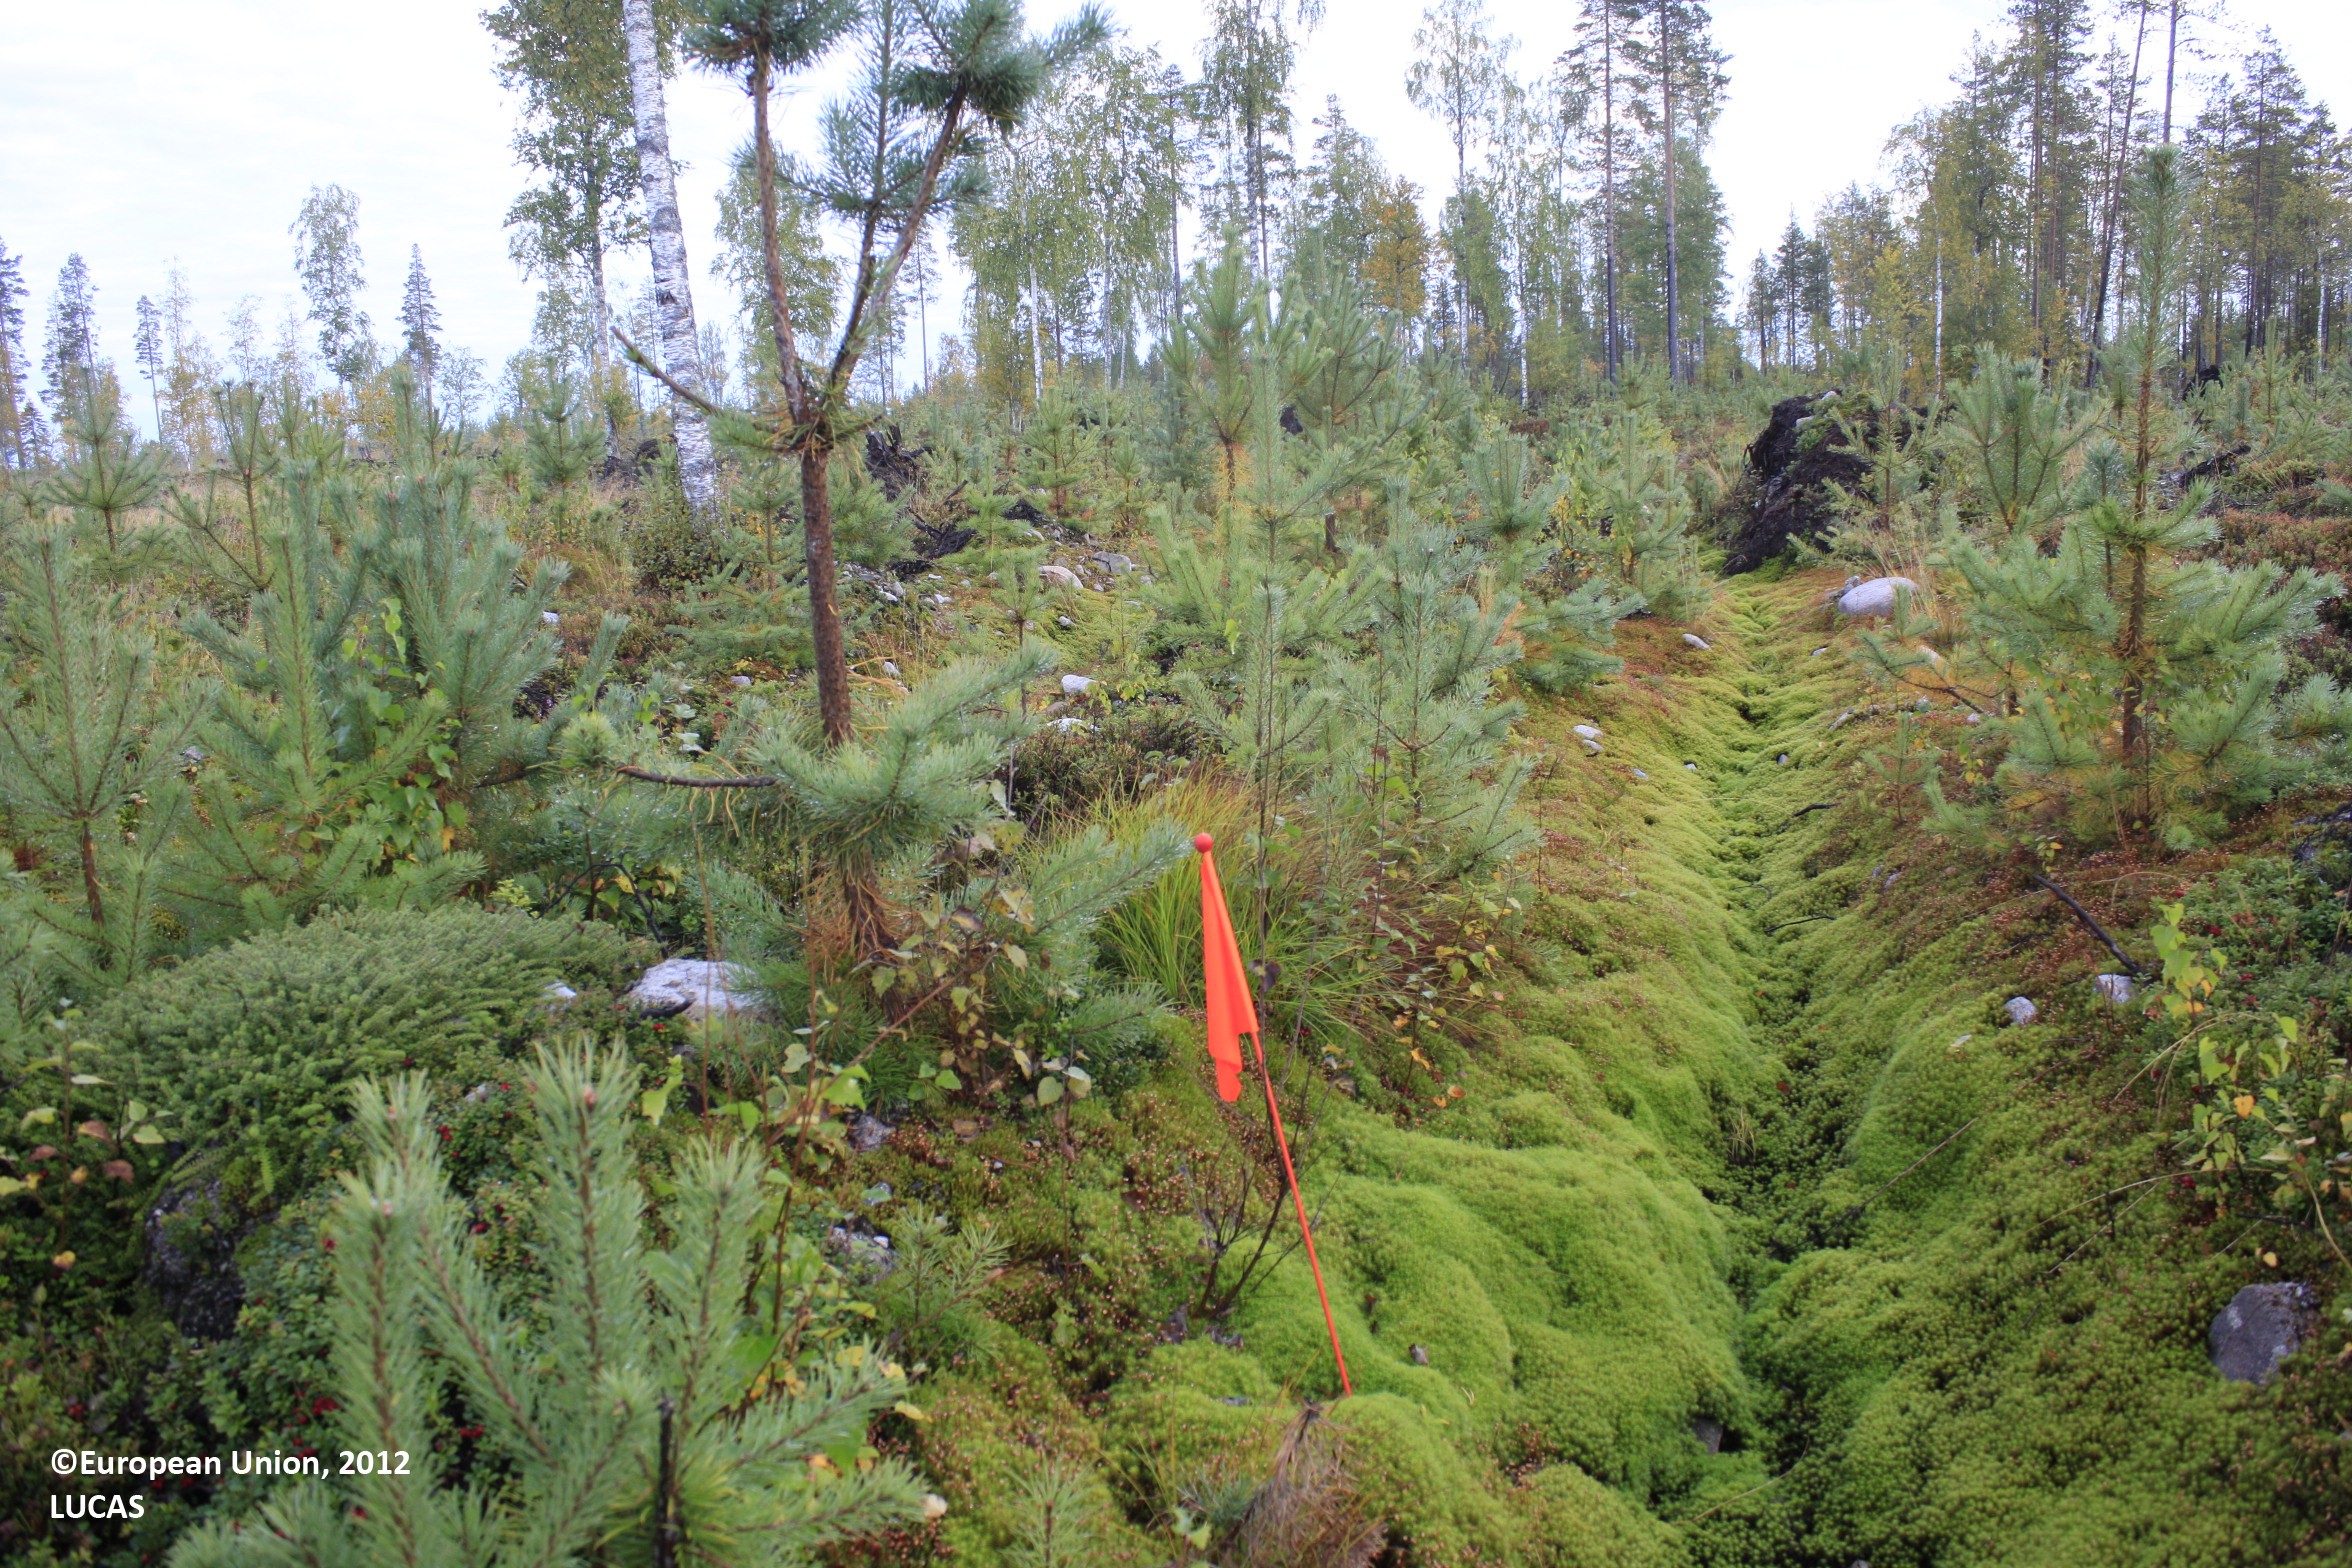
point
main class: Woodland
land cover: Pine dominated coniferous woodland
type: boreal forest
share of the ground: 25 - 50 %
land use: Forestry
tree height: < 5 m
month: September
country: FI
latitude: 65.6193
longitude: 26.7137
